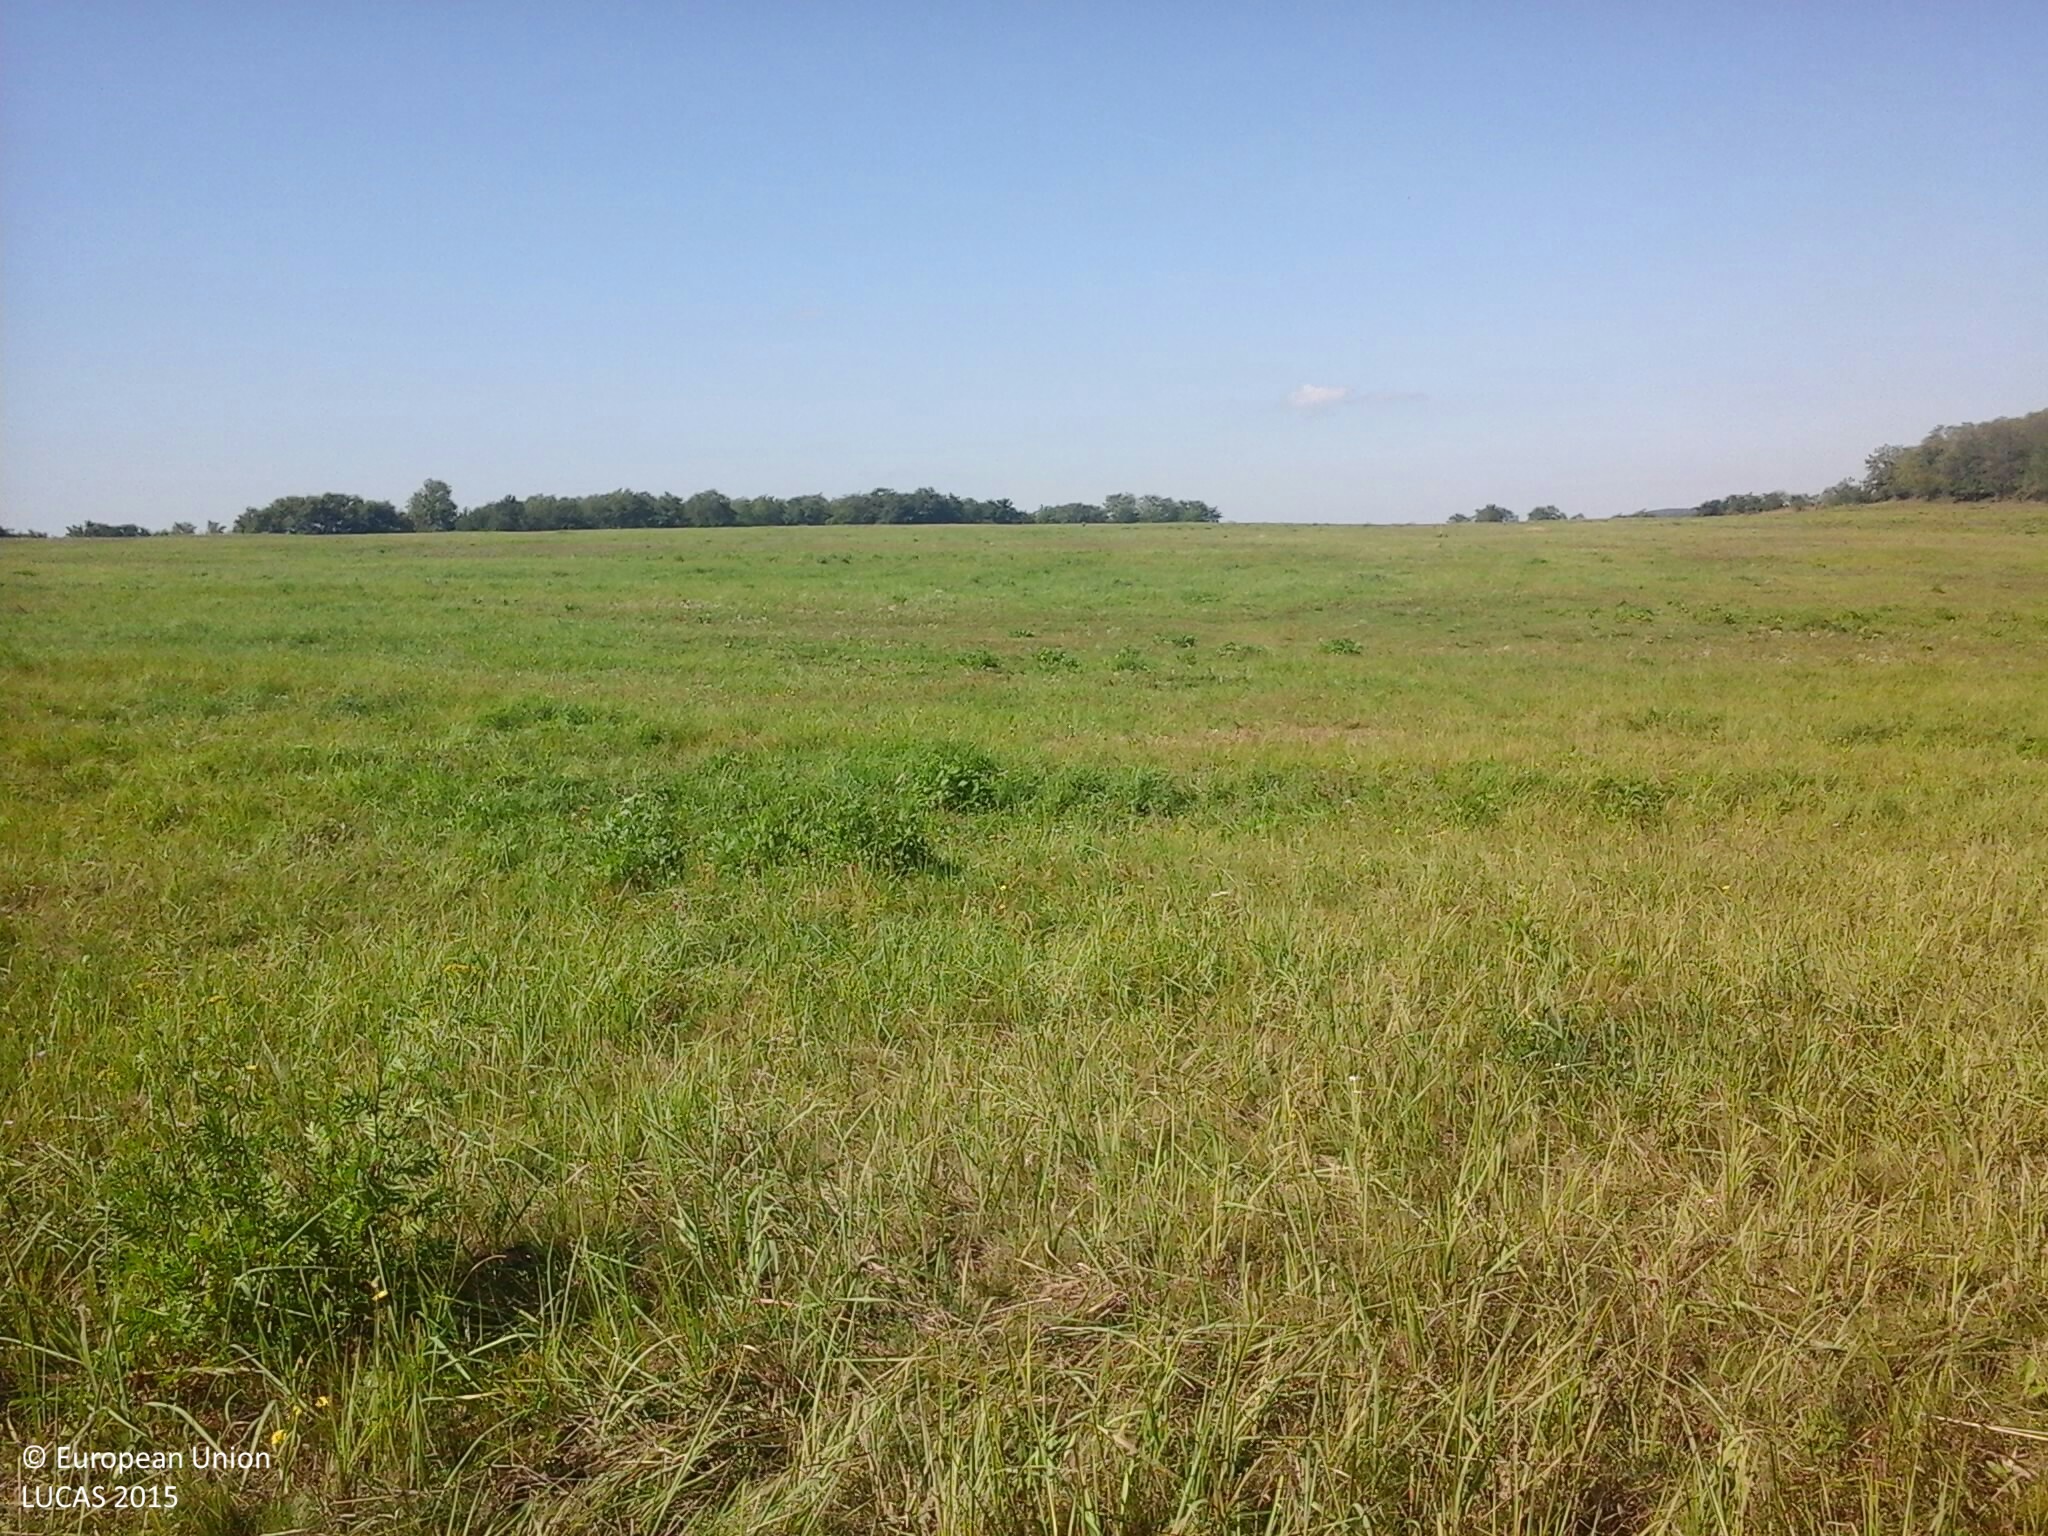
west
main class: Grassland
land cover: Grassland without tree/shrub cover
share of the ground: > 75 %
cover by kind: herbaceous plants 100 %
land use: Agriculture (excluding fallow land and kitchen gardens)
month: September
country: HU
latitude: 48.0499
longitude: 19.8874
